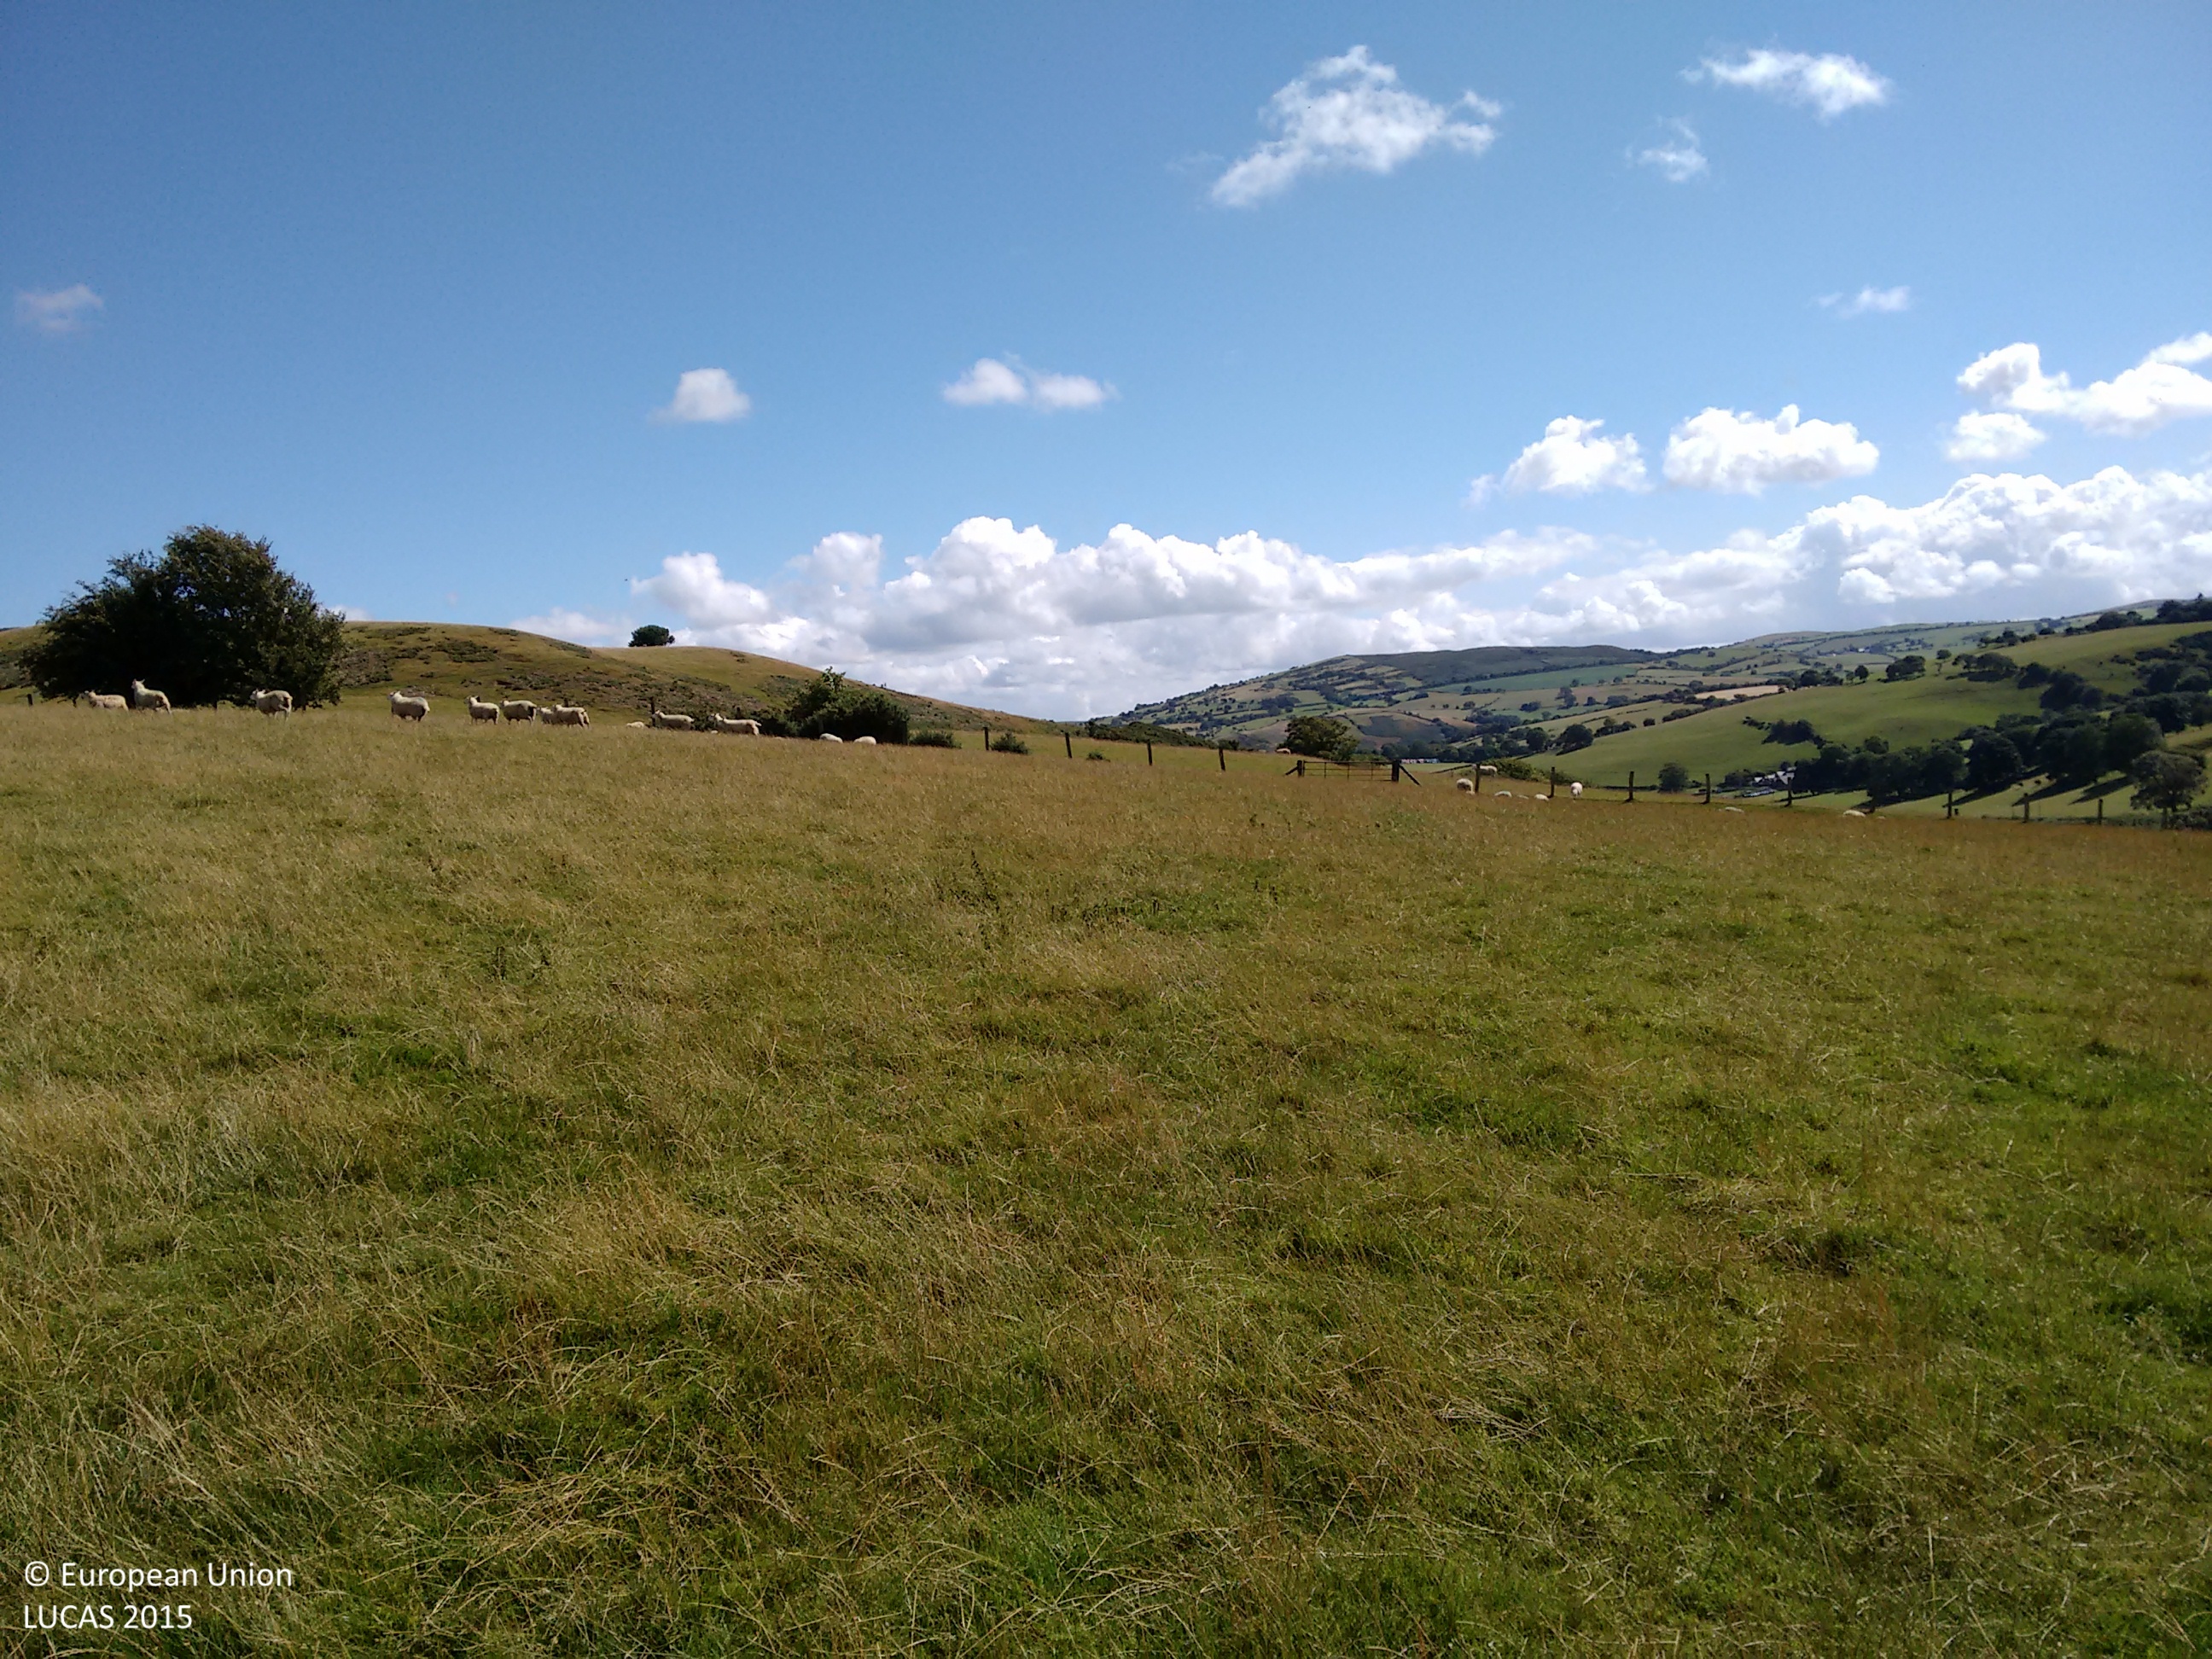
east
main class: Grassland
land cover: Grassland without tree/shrub cover
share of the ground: > 75 %
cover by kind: herbaceous plants 100 %
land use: Agriculture (excluding fallow land and kitchen gardens)
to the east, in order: Grassland without tree/shrub cover; Fences; Single bushes/trees; Grassland without tree/shrub cover; Grassland with sparse tree/shrub cover; Fences; Shrubland without tree cover; Fences; Grassland without tree/shrub cover
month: August
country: GB
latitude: 53.1701
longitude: -3.5027
